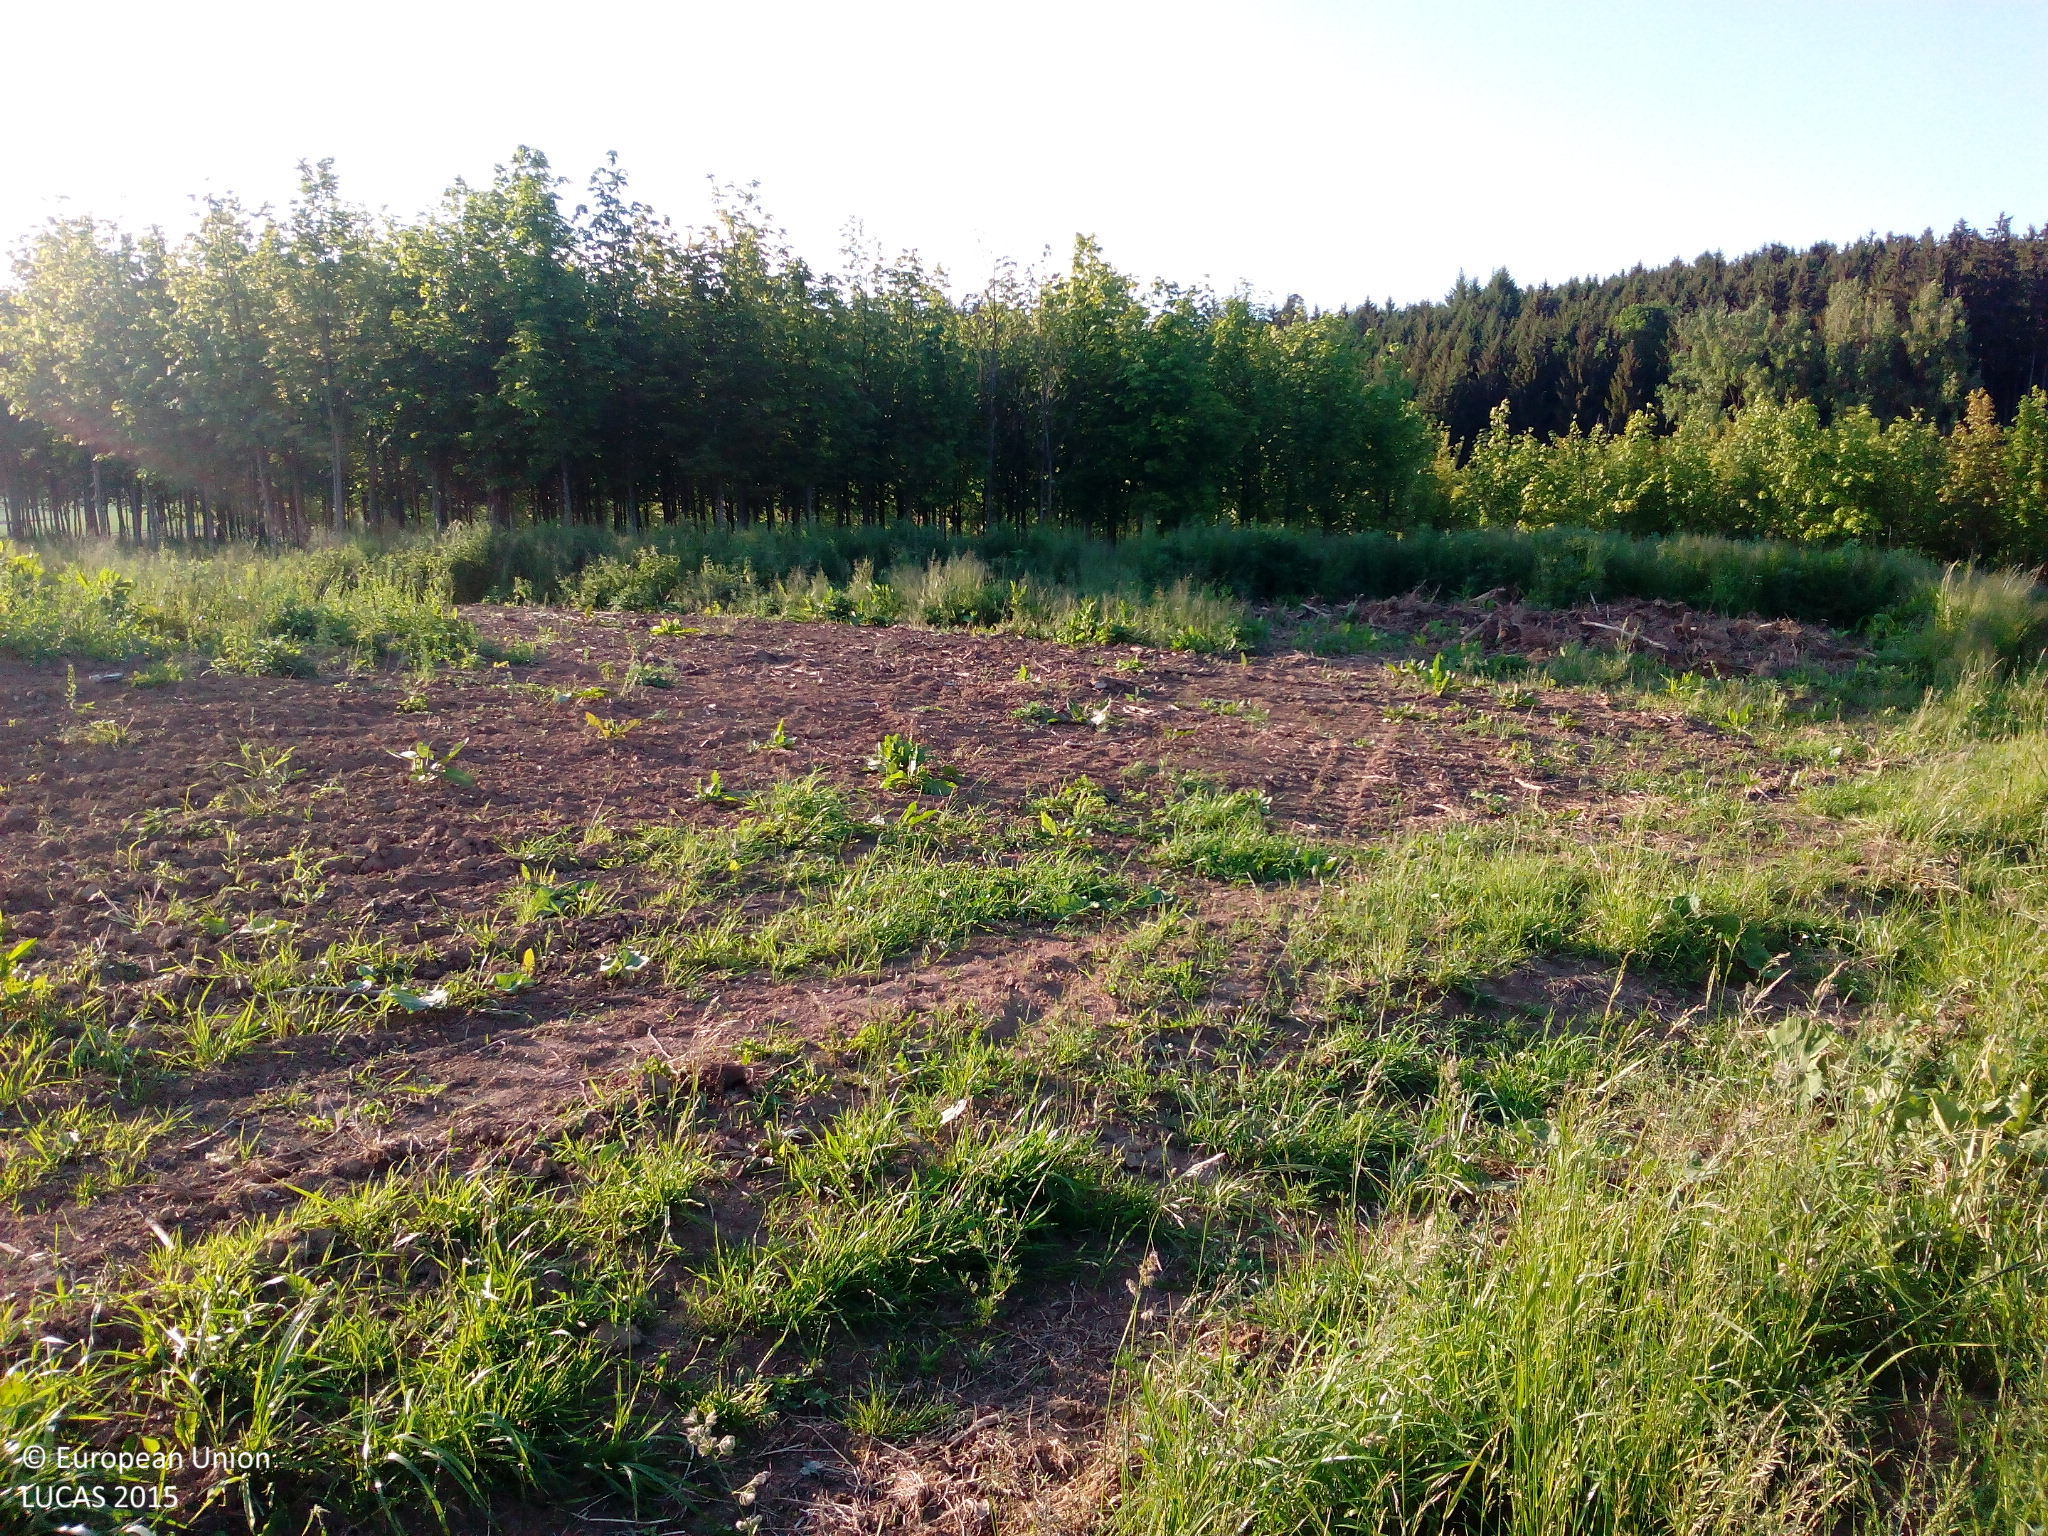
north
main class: Cropland
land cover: Common wheat
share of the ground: > 75 %
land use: Agriculture (excluding fallow land and kitchen gardens)
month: June
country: DE
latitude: 48.8698
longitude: 12.0852
